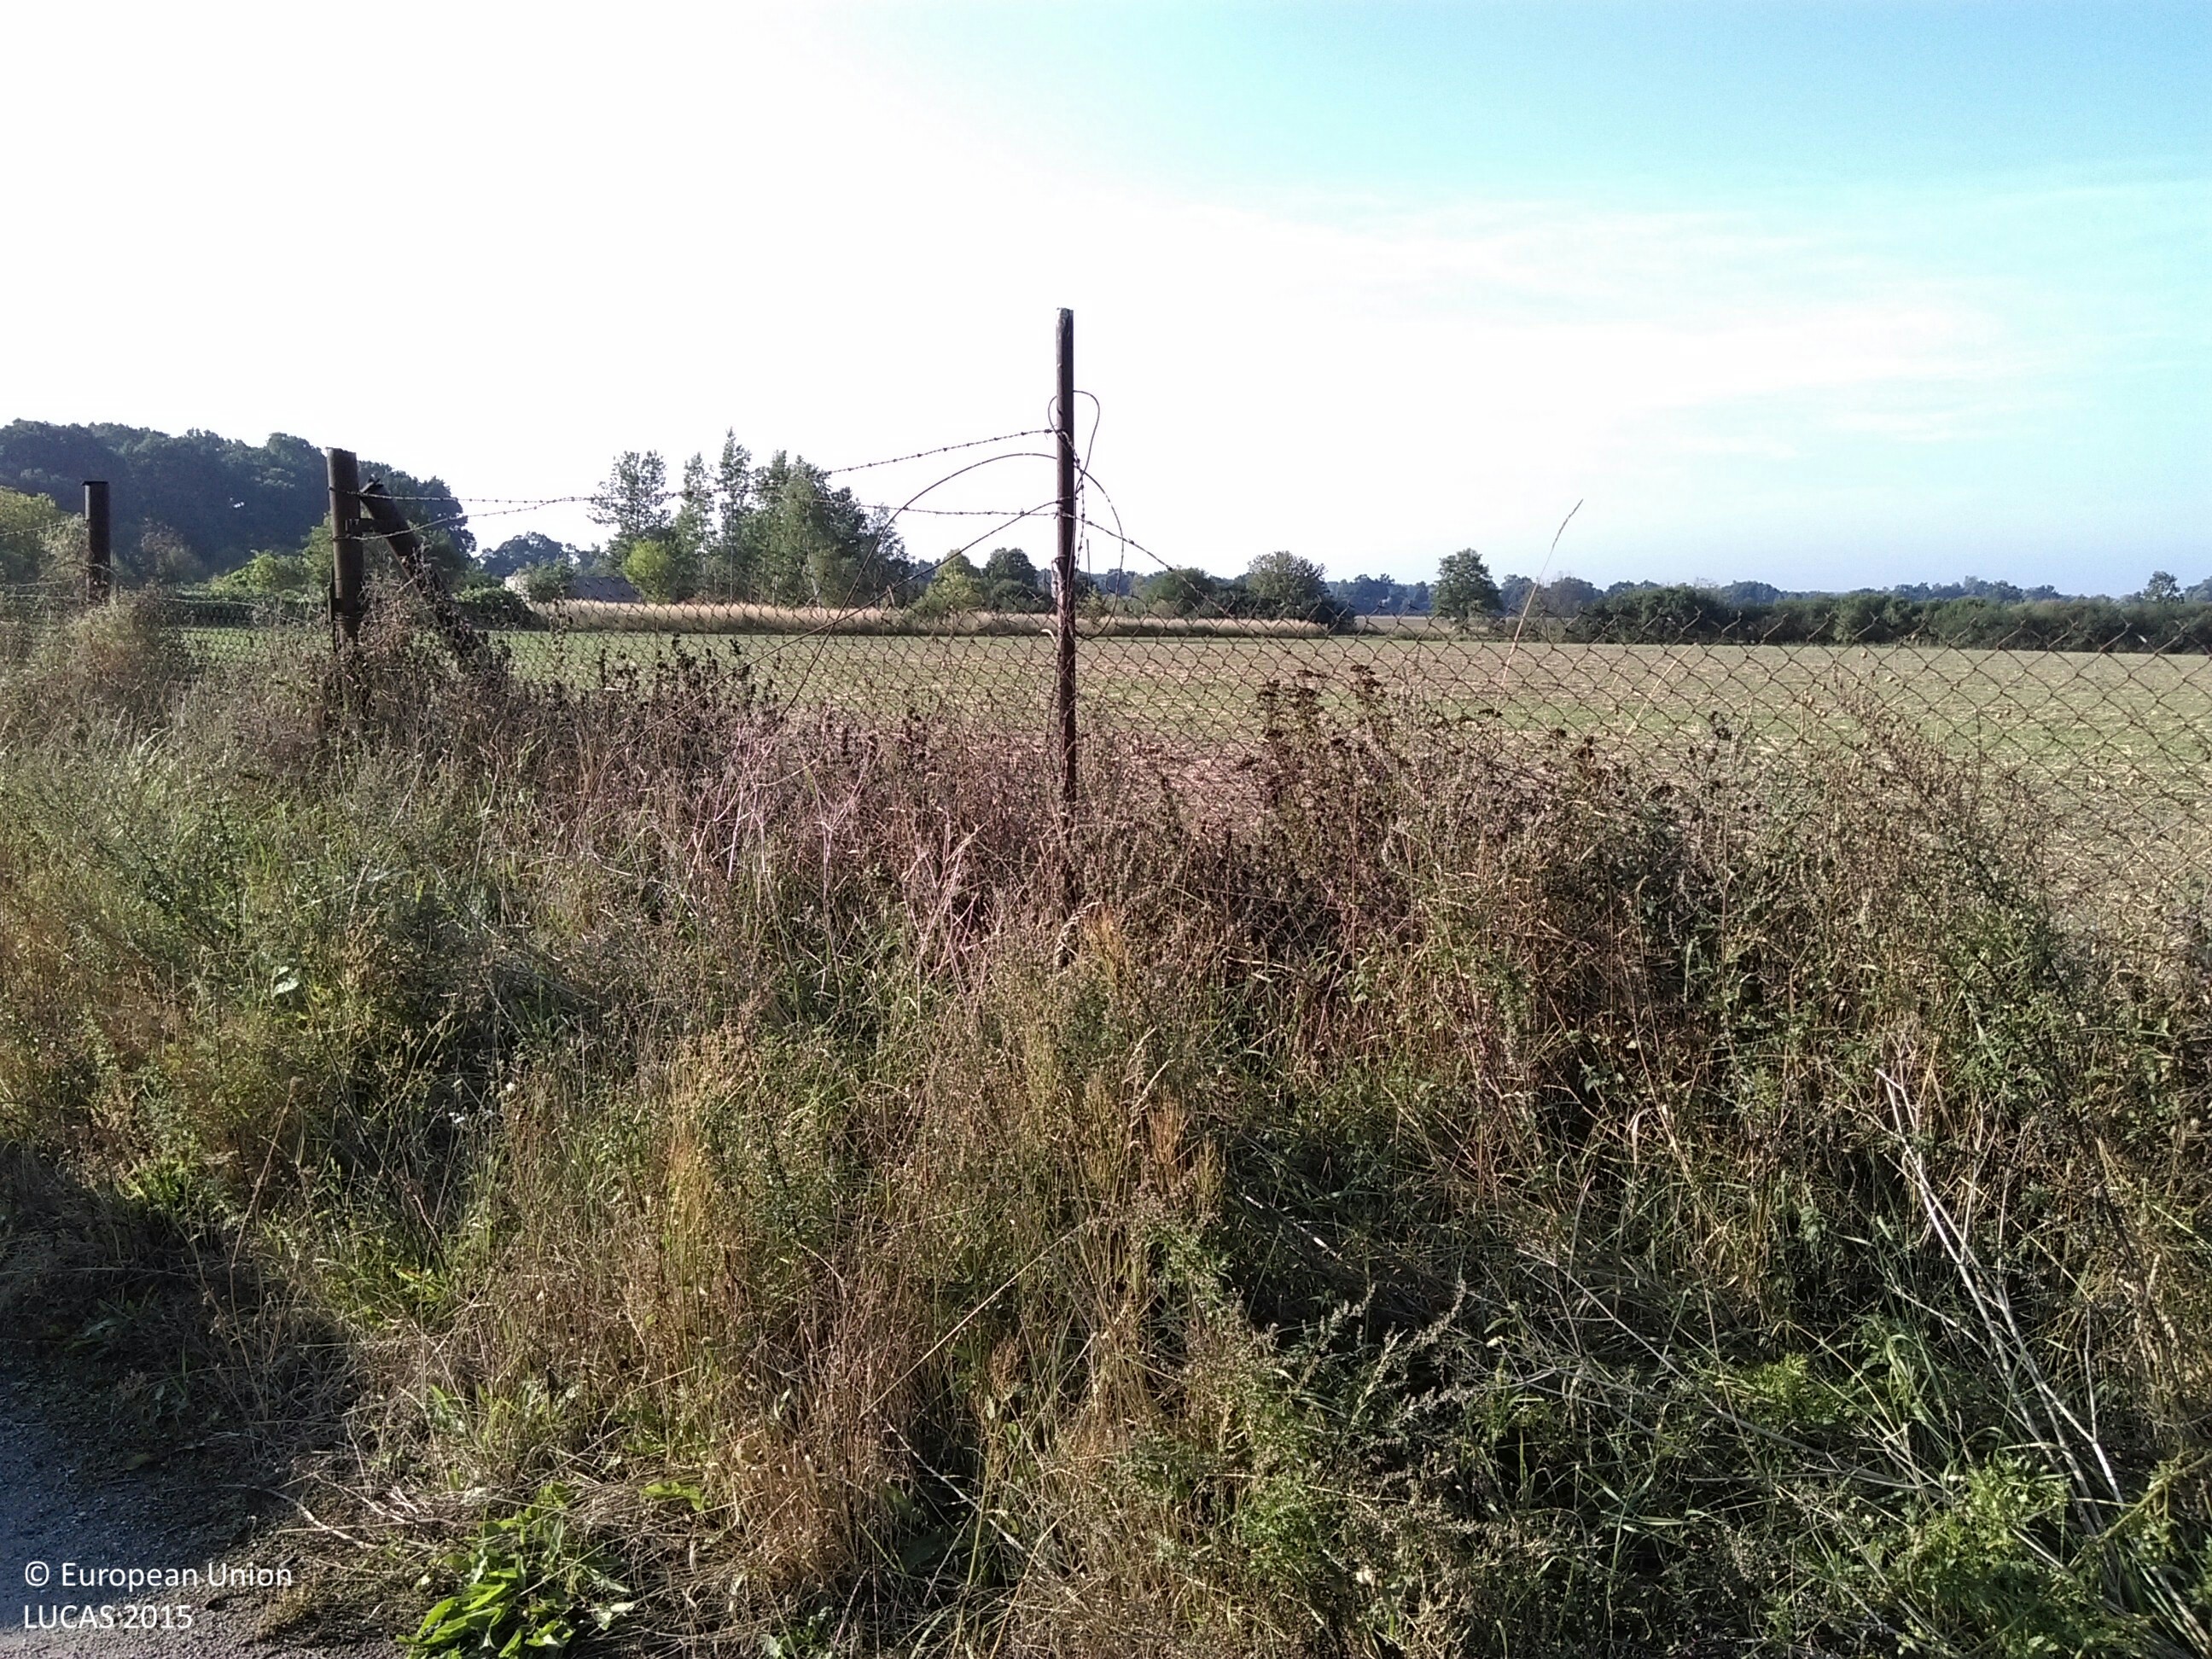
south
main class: Cropland
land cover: Triticale
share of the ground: < 10 %
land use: Agriculture (excluding fallow land and kitchen gardens)
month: September
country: PL
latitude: 51.7969
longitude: 15.5579
